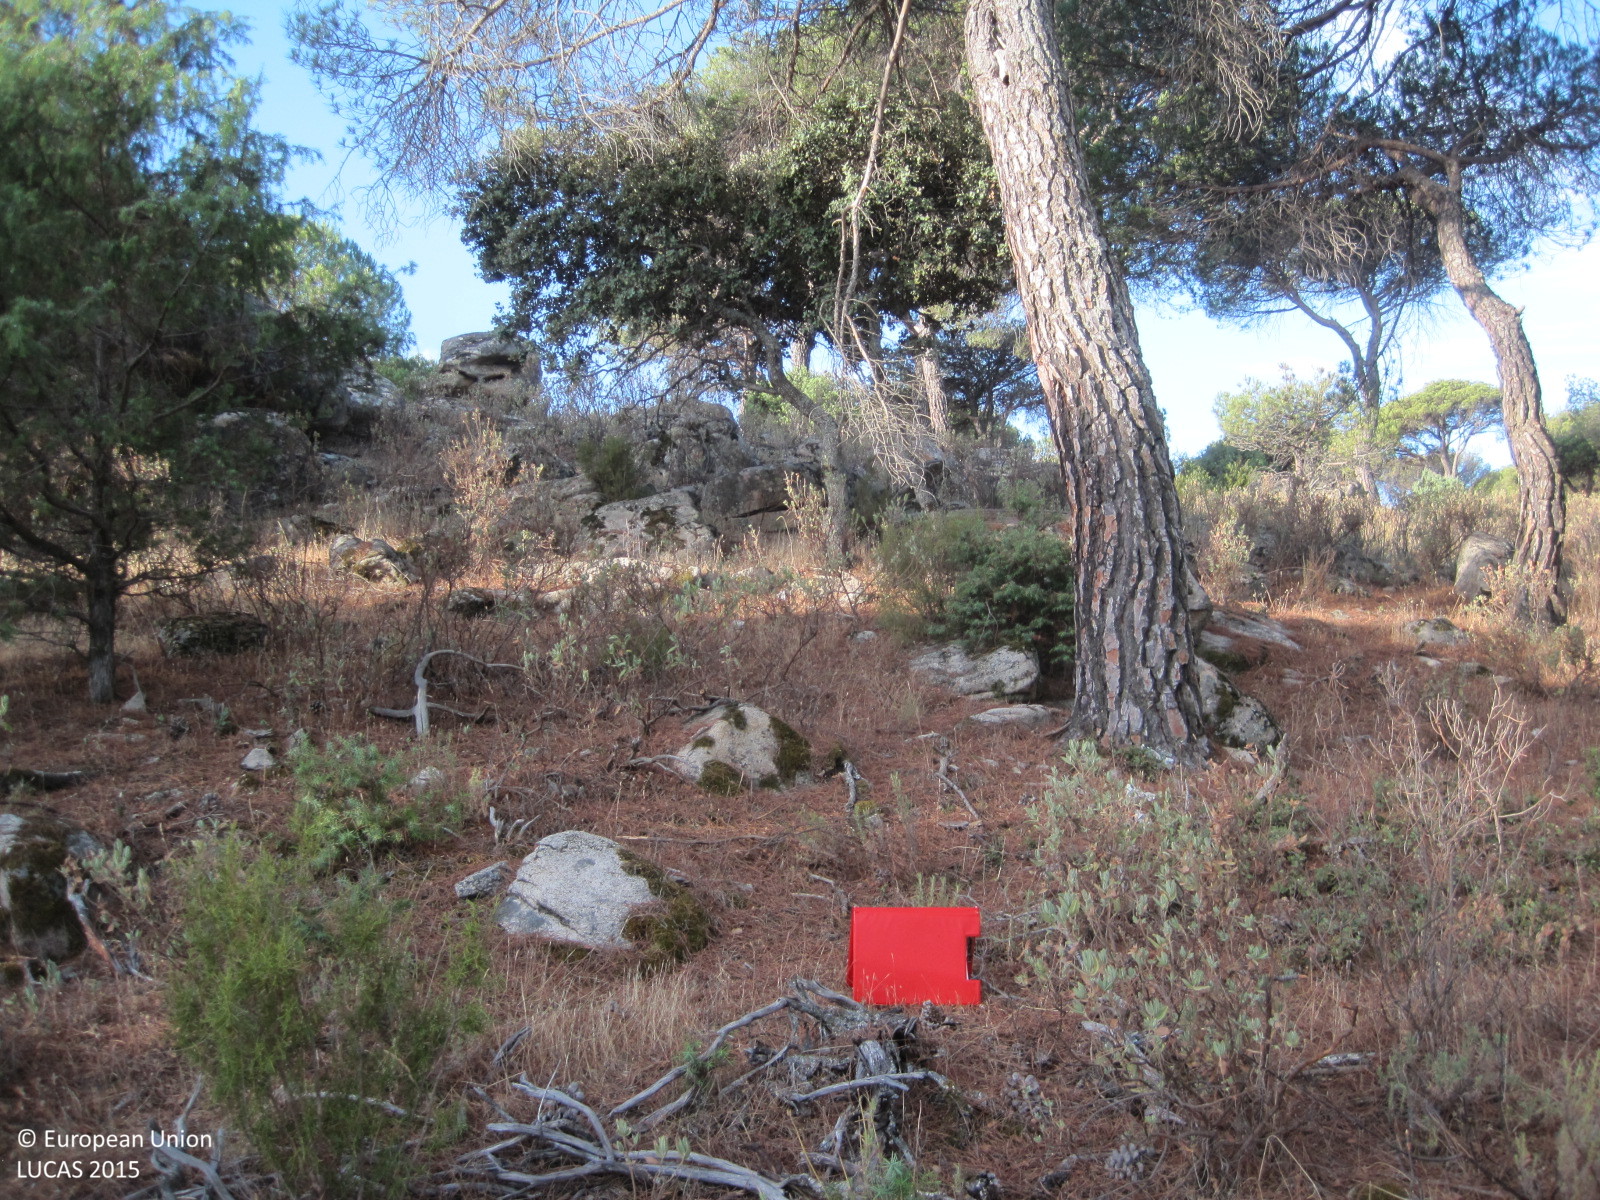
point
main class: Woodland
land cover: Pine dominated mixed woodland
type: coniferous forest of the mediterranean region
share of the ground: > 75 %
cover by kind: coniferous forest trees 50 %, broadleaved forest trees 25 %, shrubs 10 %, herbaceous plants 10 %, unconsolidated bare surface 5 %
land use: Semi-natural and natural areas not in use
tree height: > 5 m
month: July
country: ES
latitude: 40.3401
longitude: -4.3724
